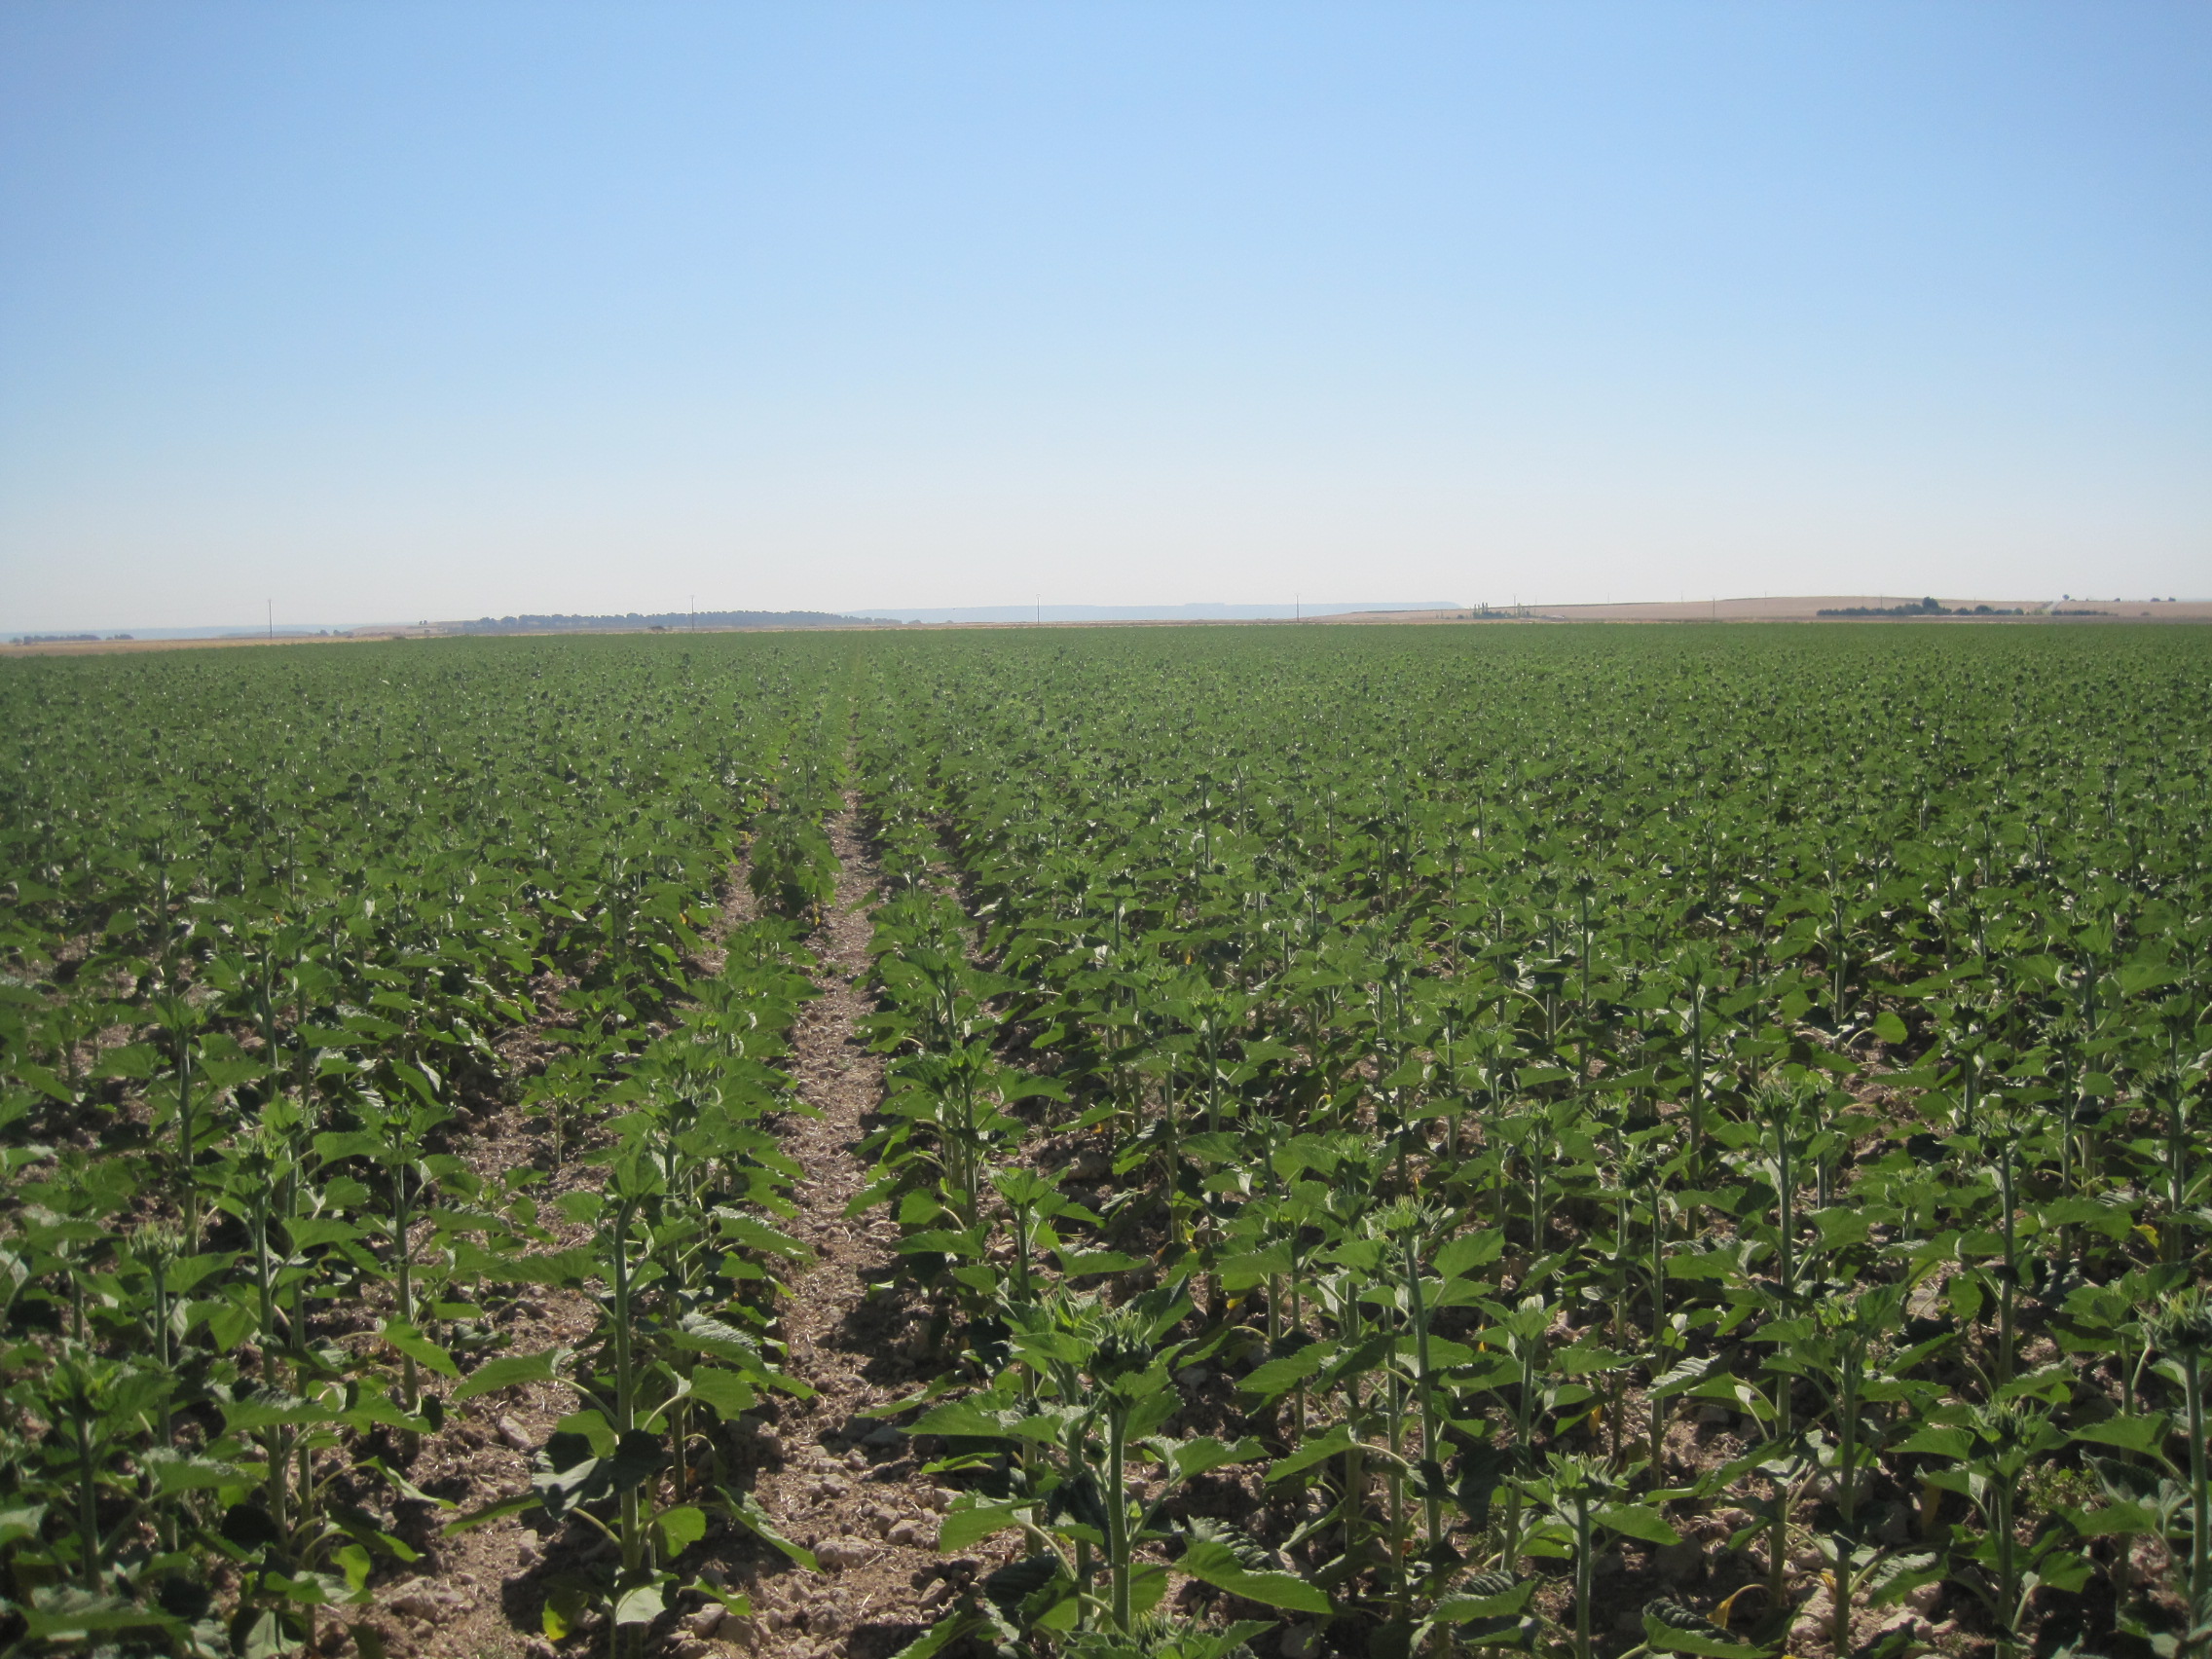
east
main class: Cropland
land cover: Sunflower
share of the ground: > 75 %
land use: Agriculture (excluding fallow land and kitchen gardens)
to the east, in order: Sunflower; Barley
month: July
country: ES
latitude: 41.8383
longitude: -4.6535
